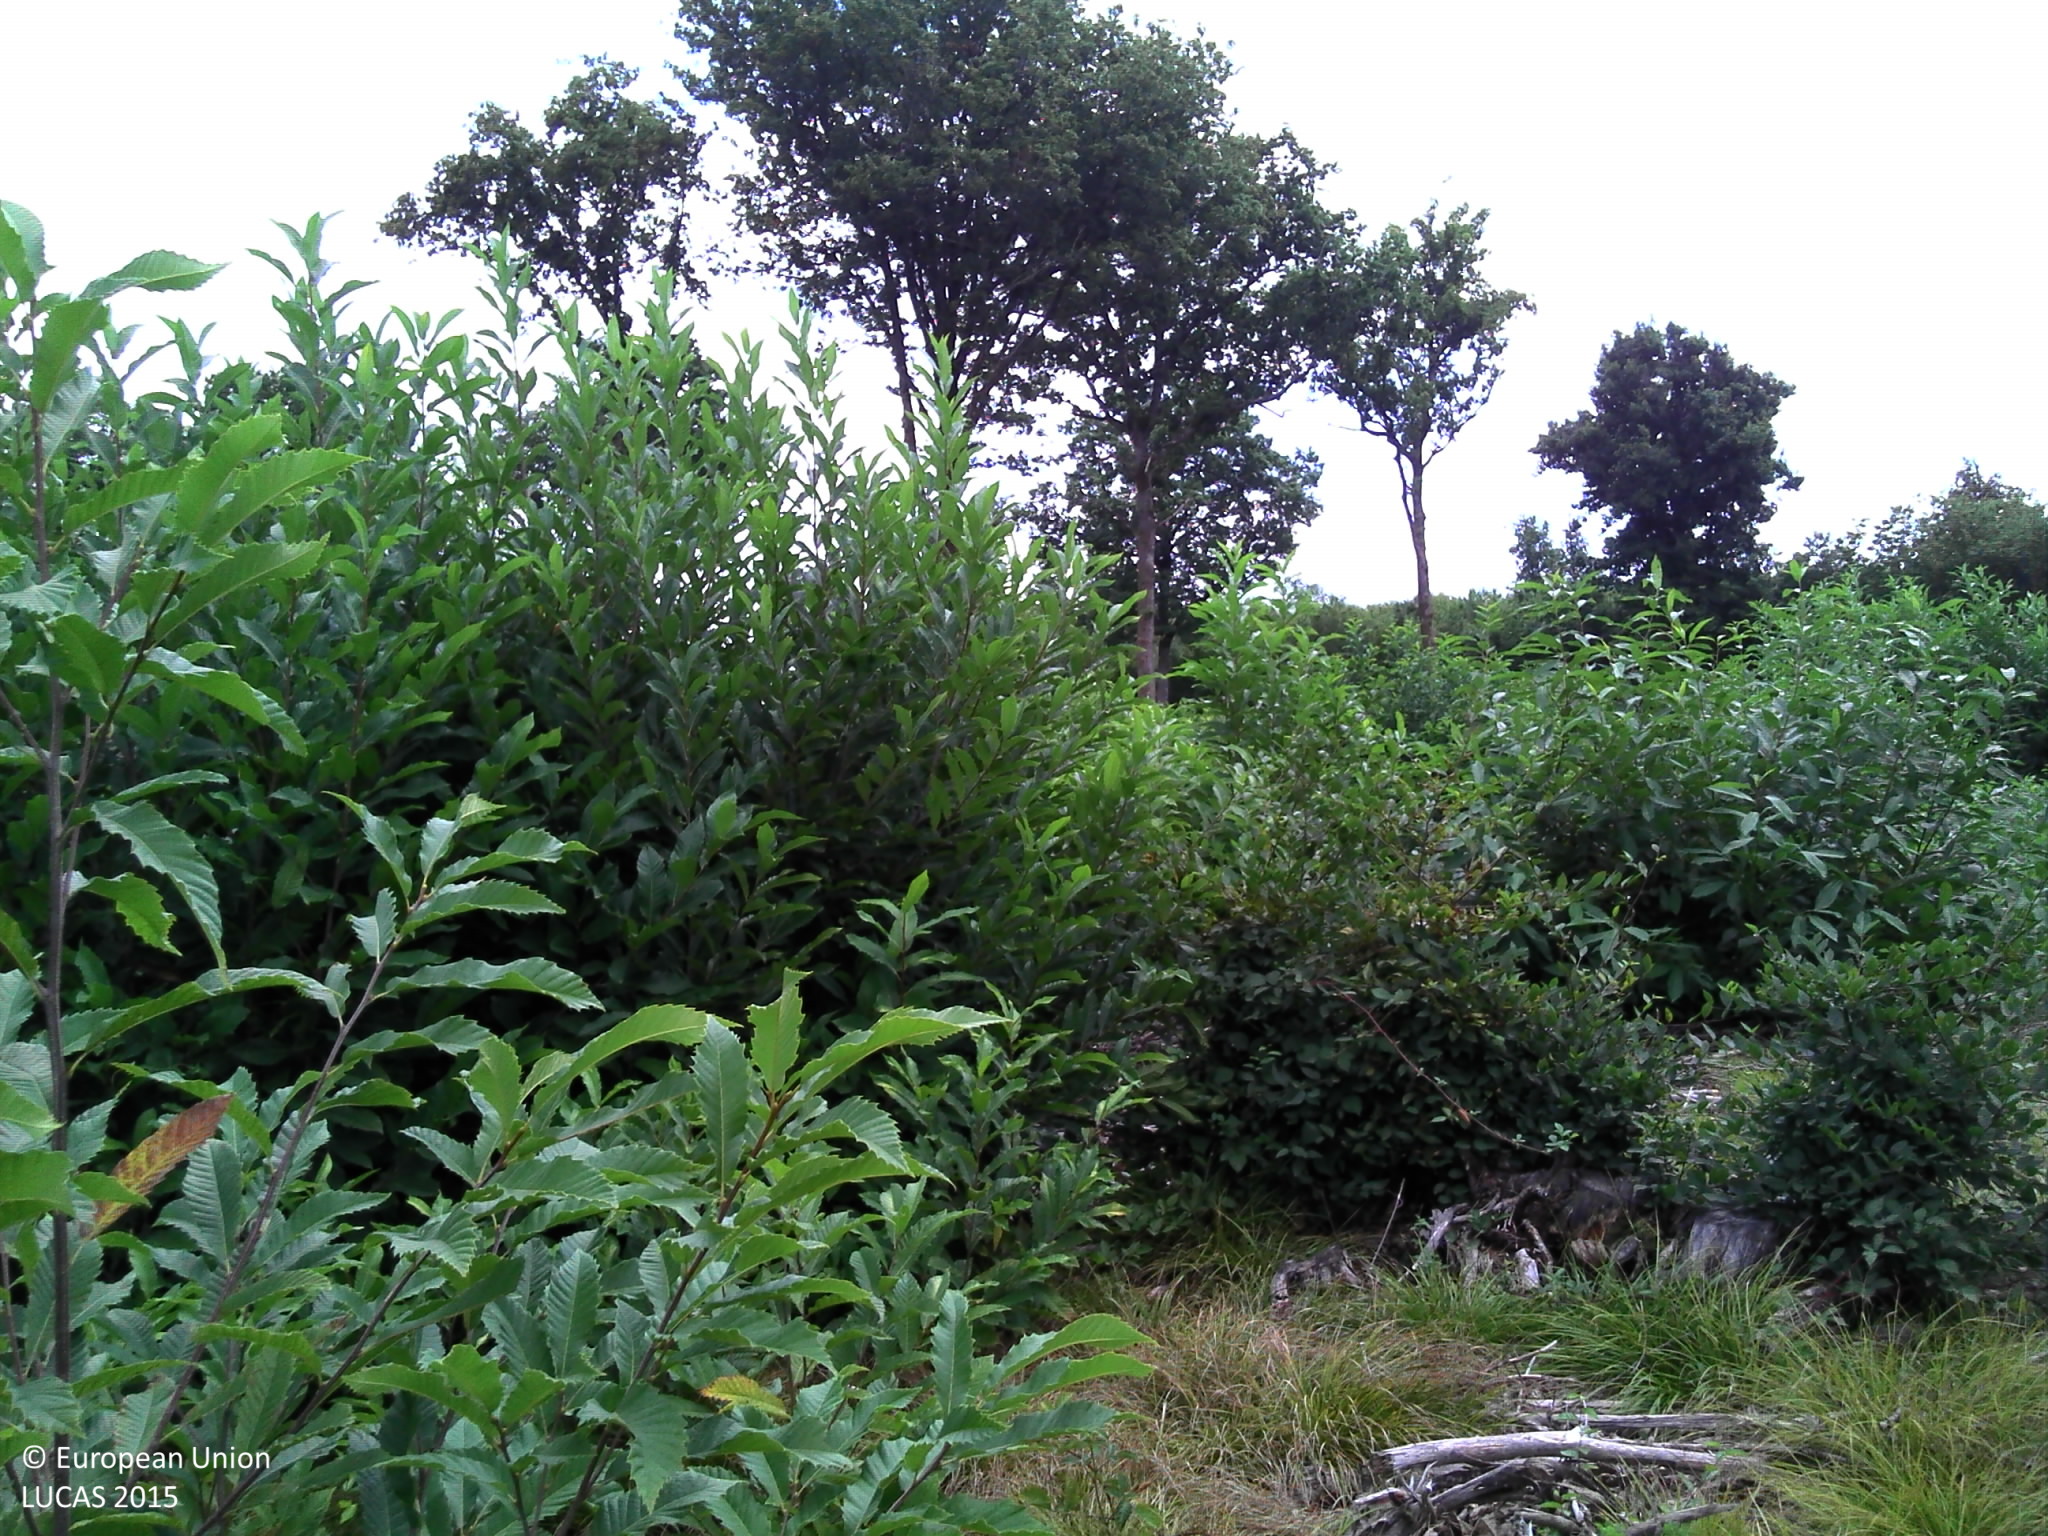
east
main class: Woodland
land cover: Broadleaved woodland
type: acidophilous oak and oak-birch forest
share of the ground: > 75 %
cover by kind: broadleaved forest trees 85 %, herbaceous plants 10 %, shrubs 5 %
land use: Forestry
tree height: < 5 m
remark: Clear cut
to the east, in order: Broadleaved woodland
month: August
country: FR
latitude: 46.1283
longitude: 0.3147
